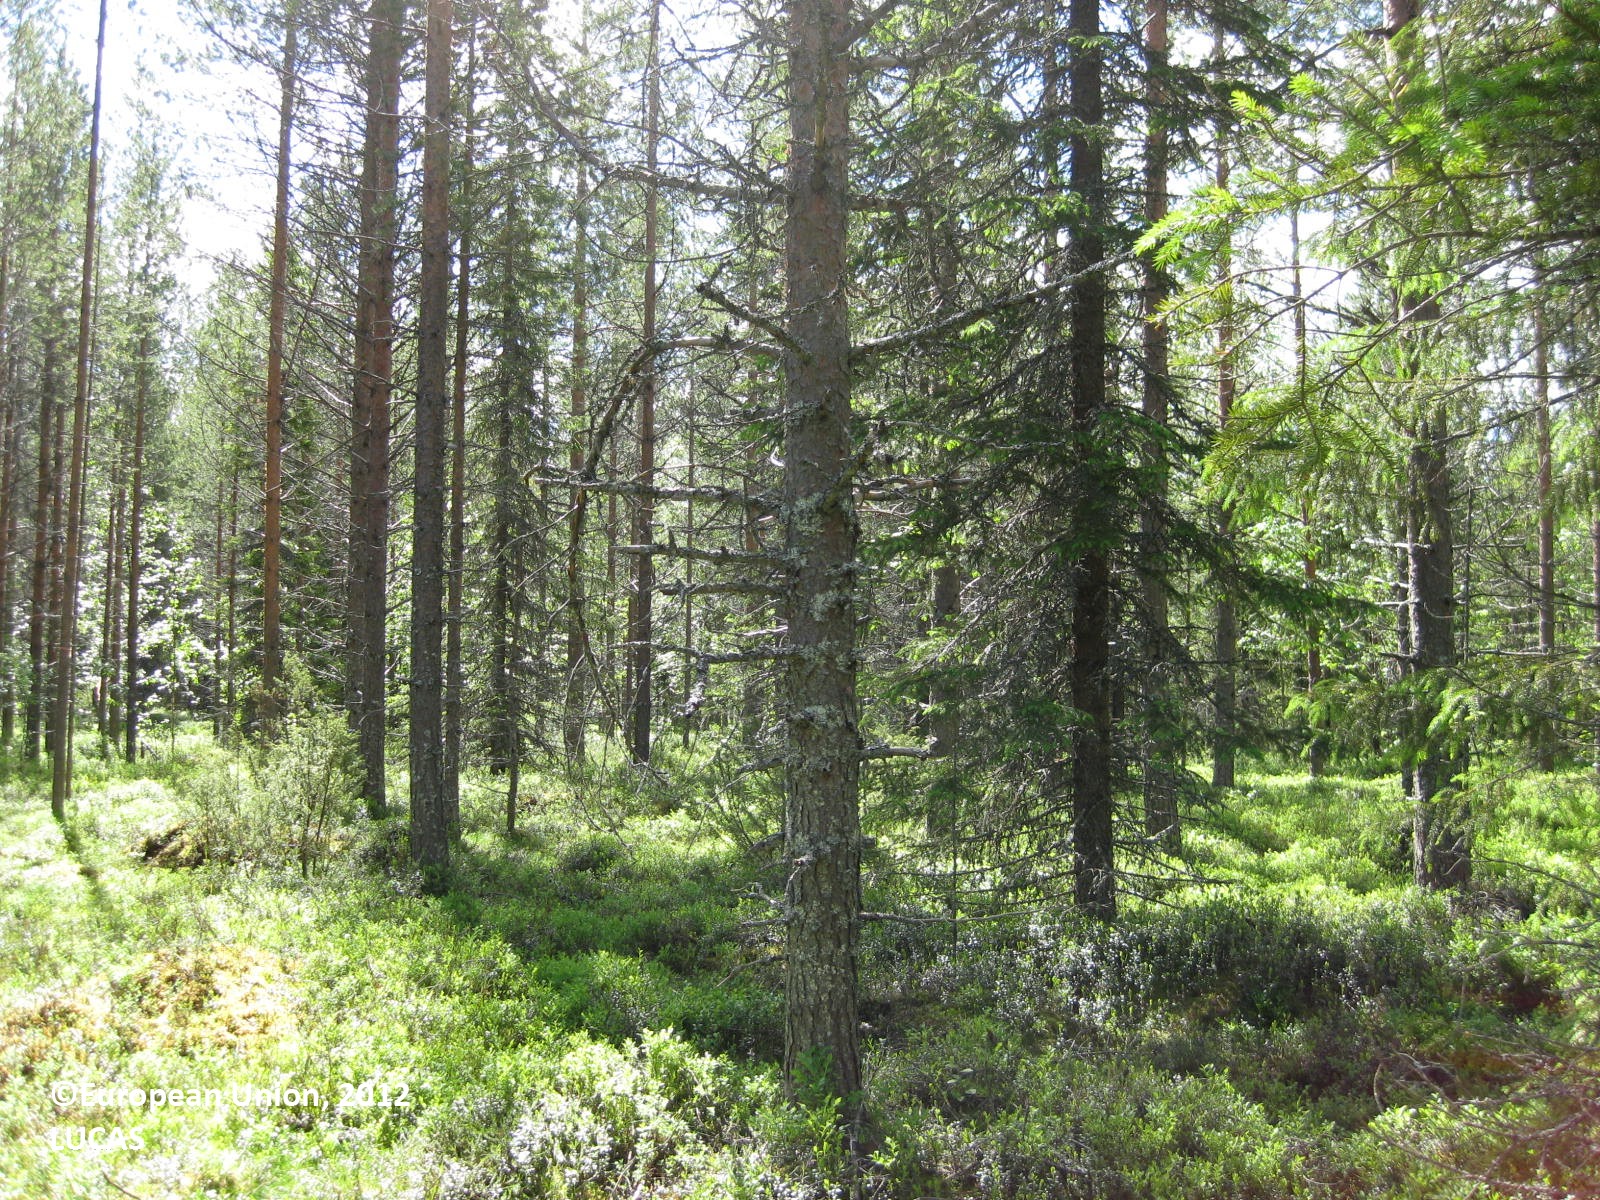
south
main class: Woodland
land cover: Other coniferous woodland
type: boreal forest
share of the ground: 50 - 75 %
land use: Forestry
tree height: > 5 m
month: June
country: FI
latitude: 65.3743
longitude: 28.2874
